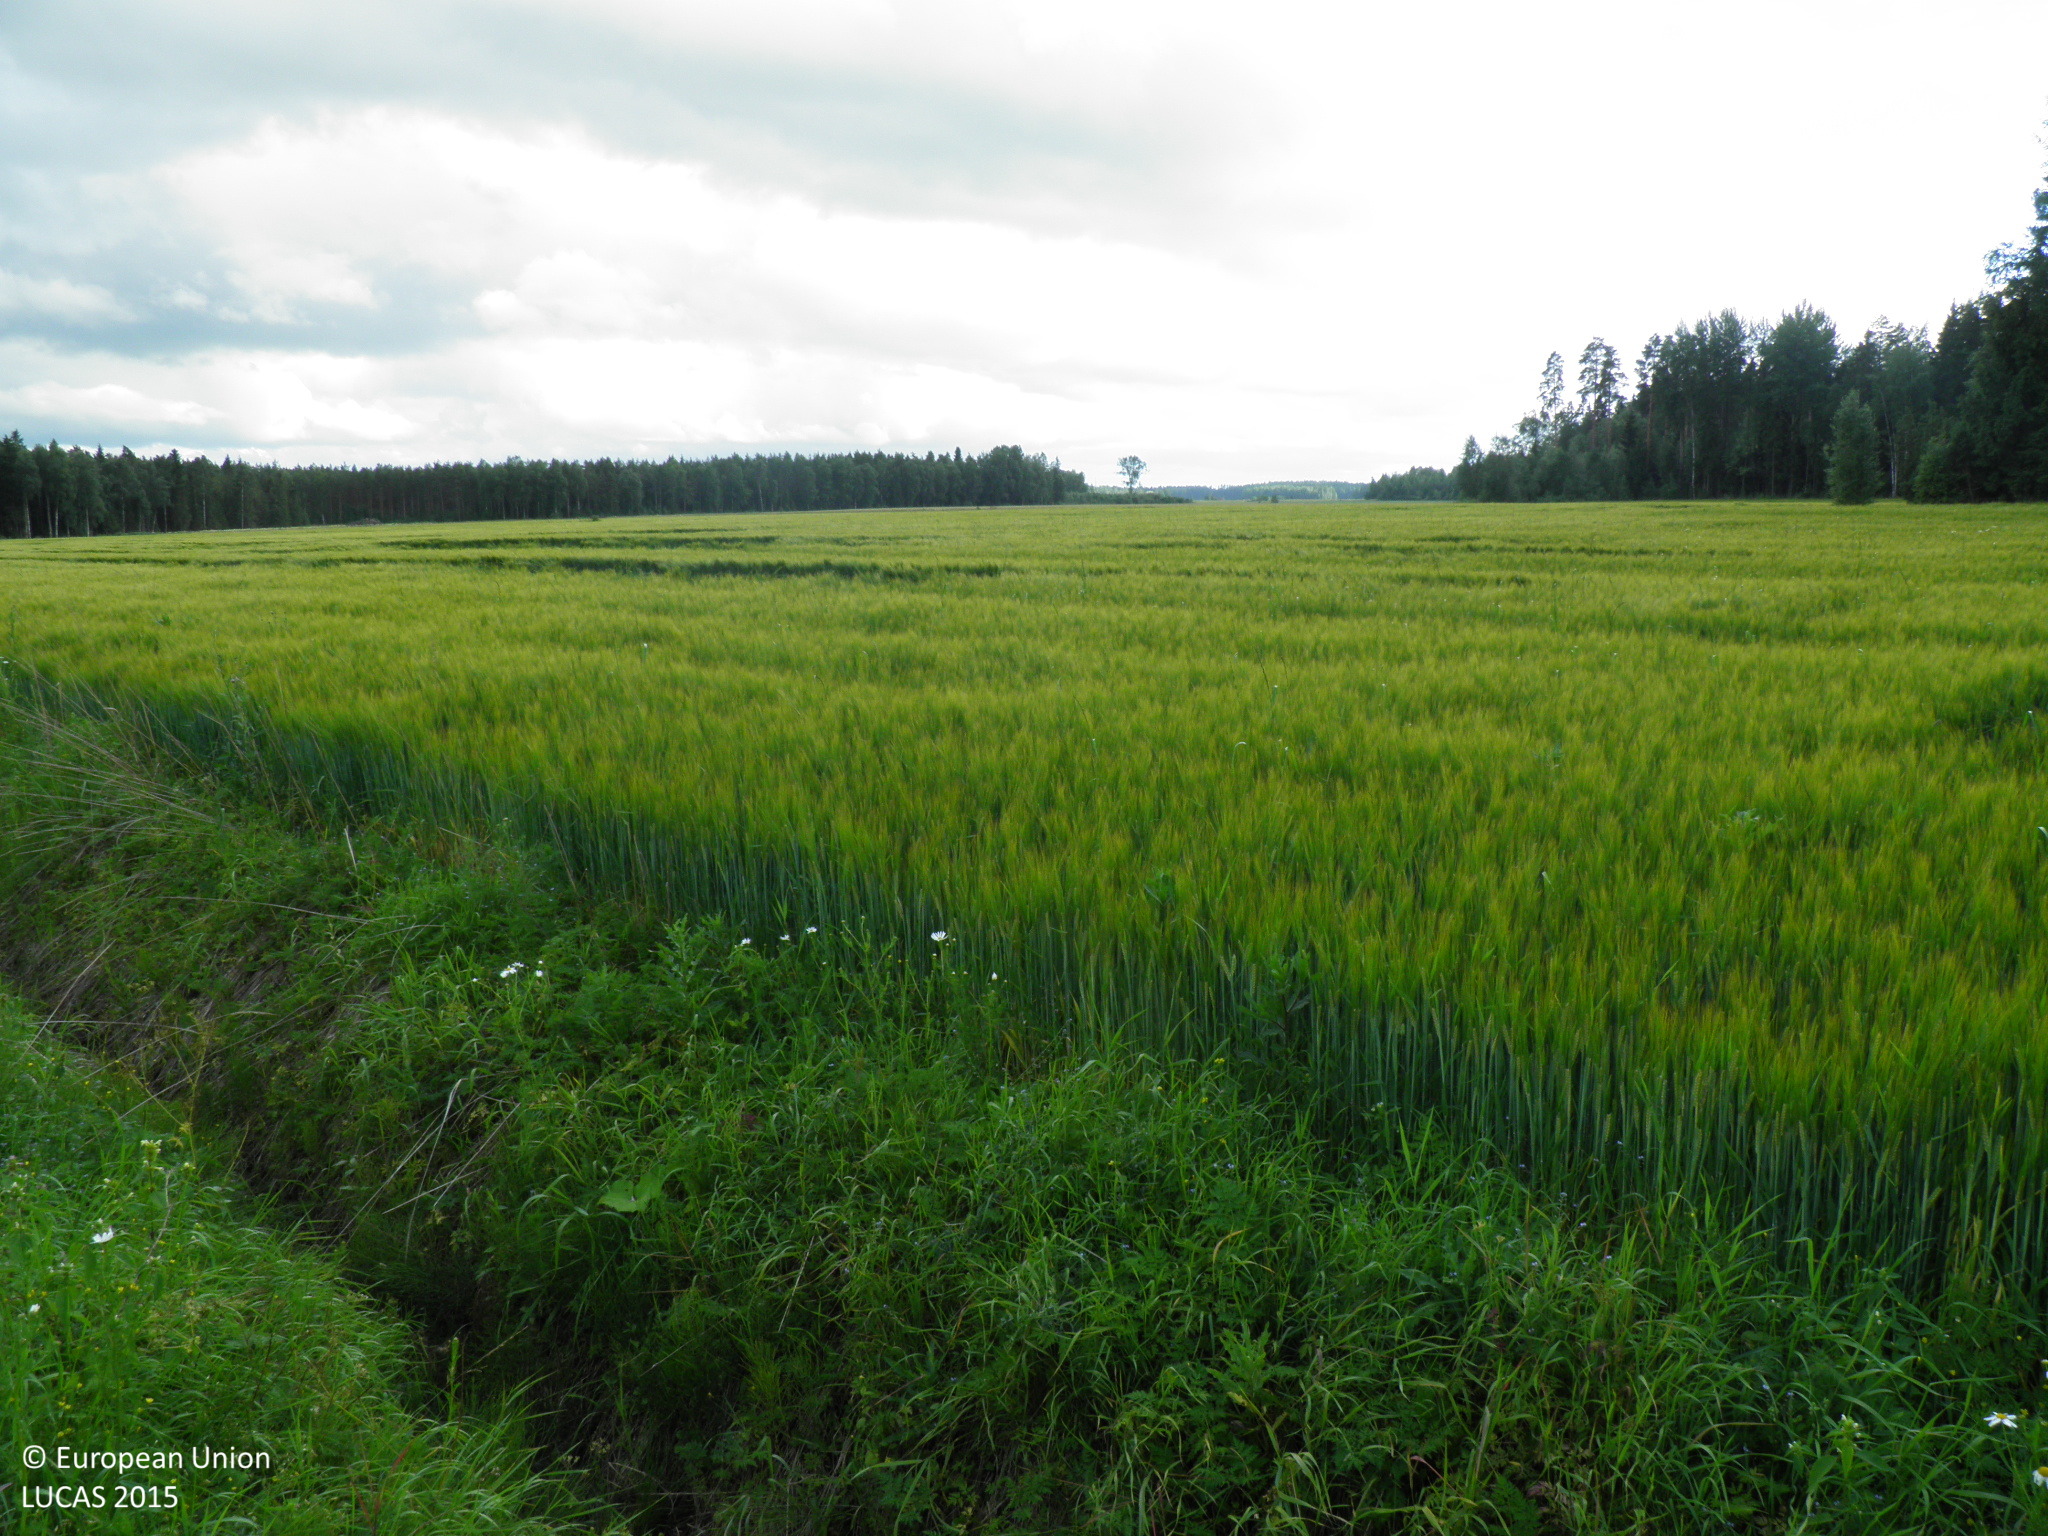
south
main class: Cropland
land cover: Barley
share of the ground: > 75 %
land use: Agriculture (excluding fallow land and kitchen gardens)
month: July
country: FI
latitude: 60.9447
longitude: 22.8273
